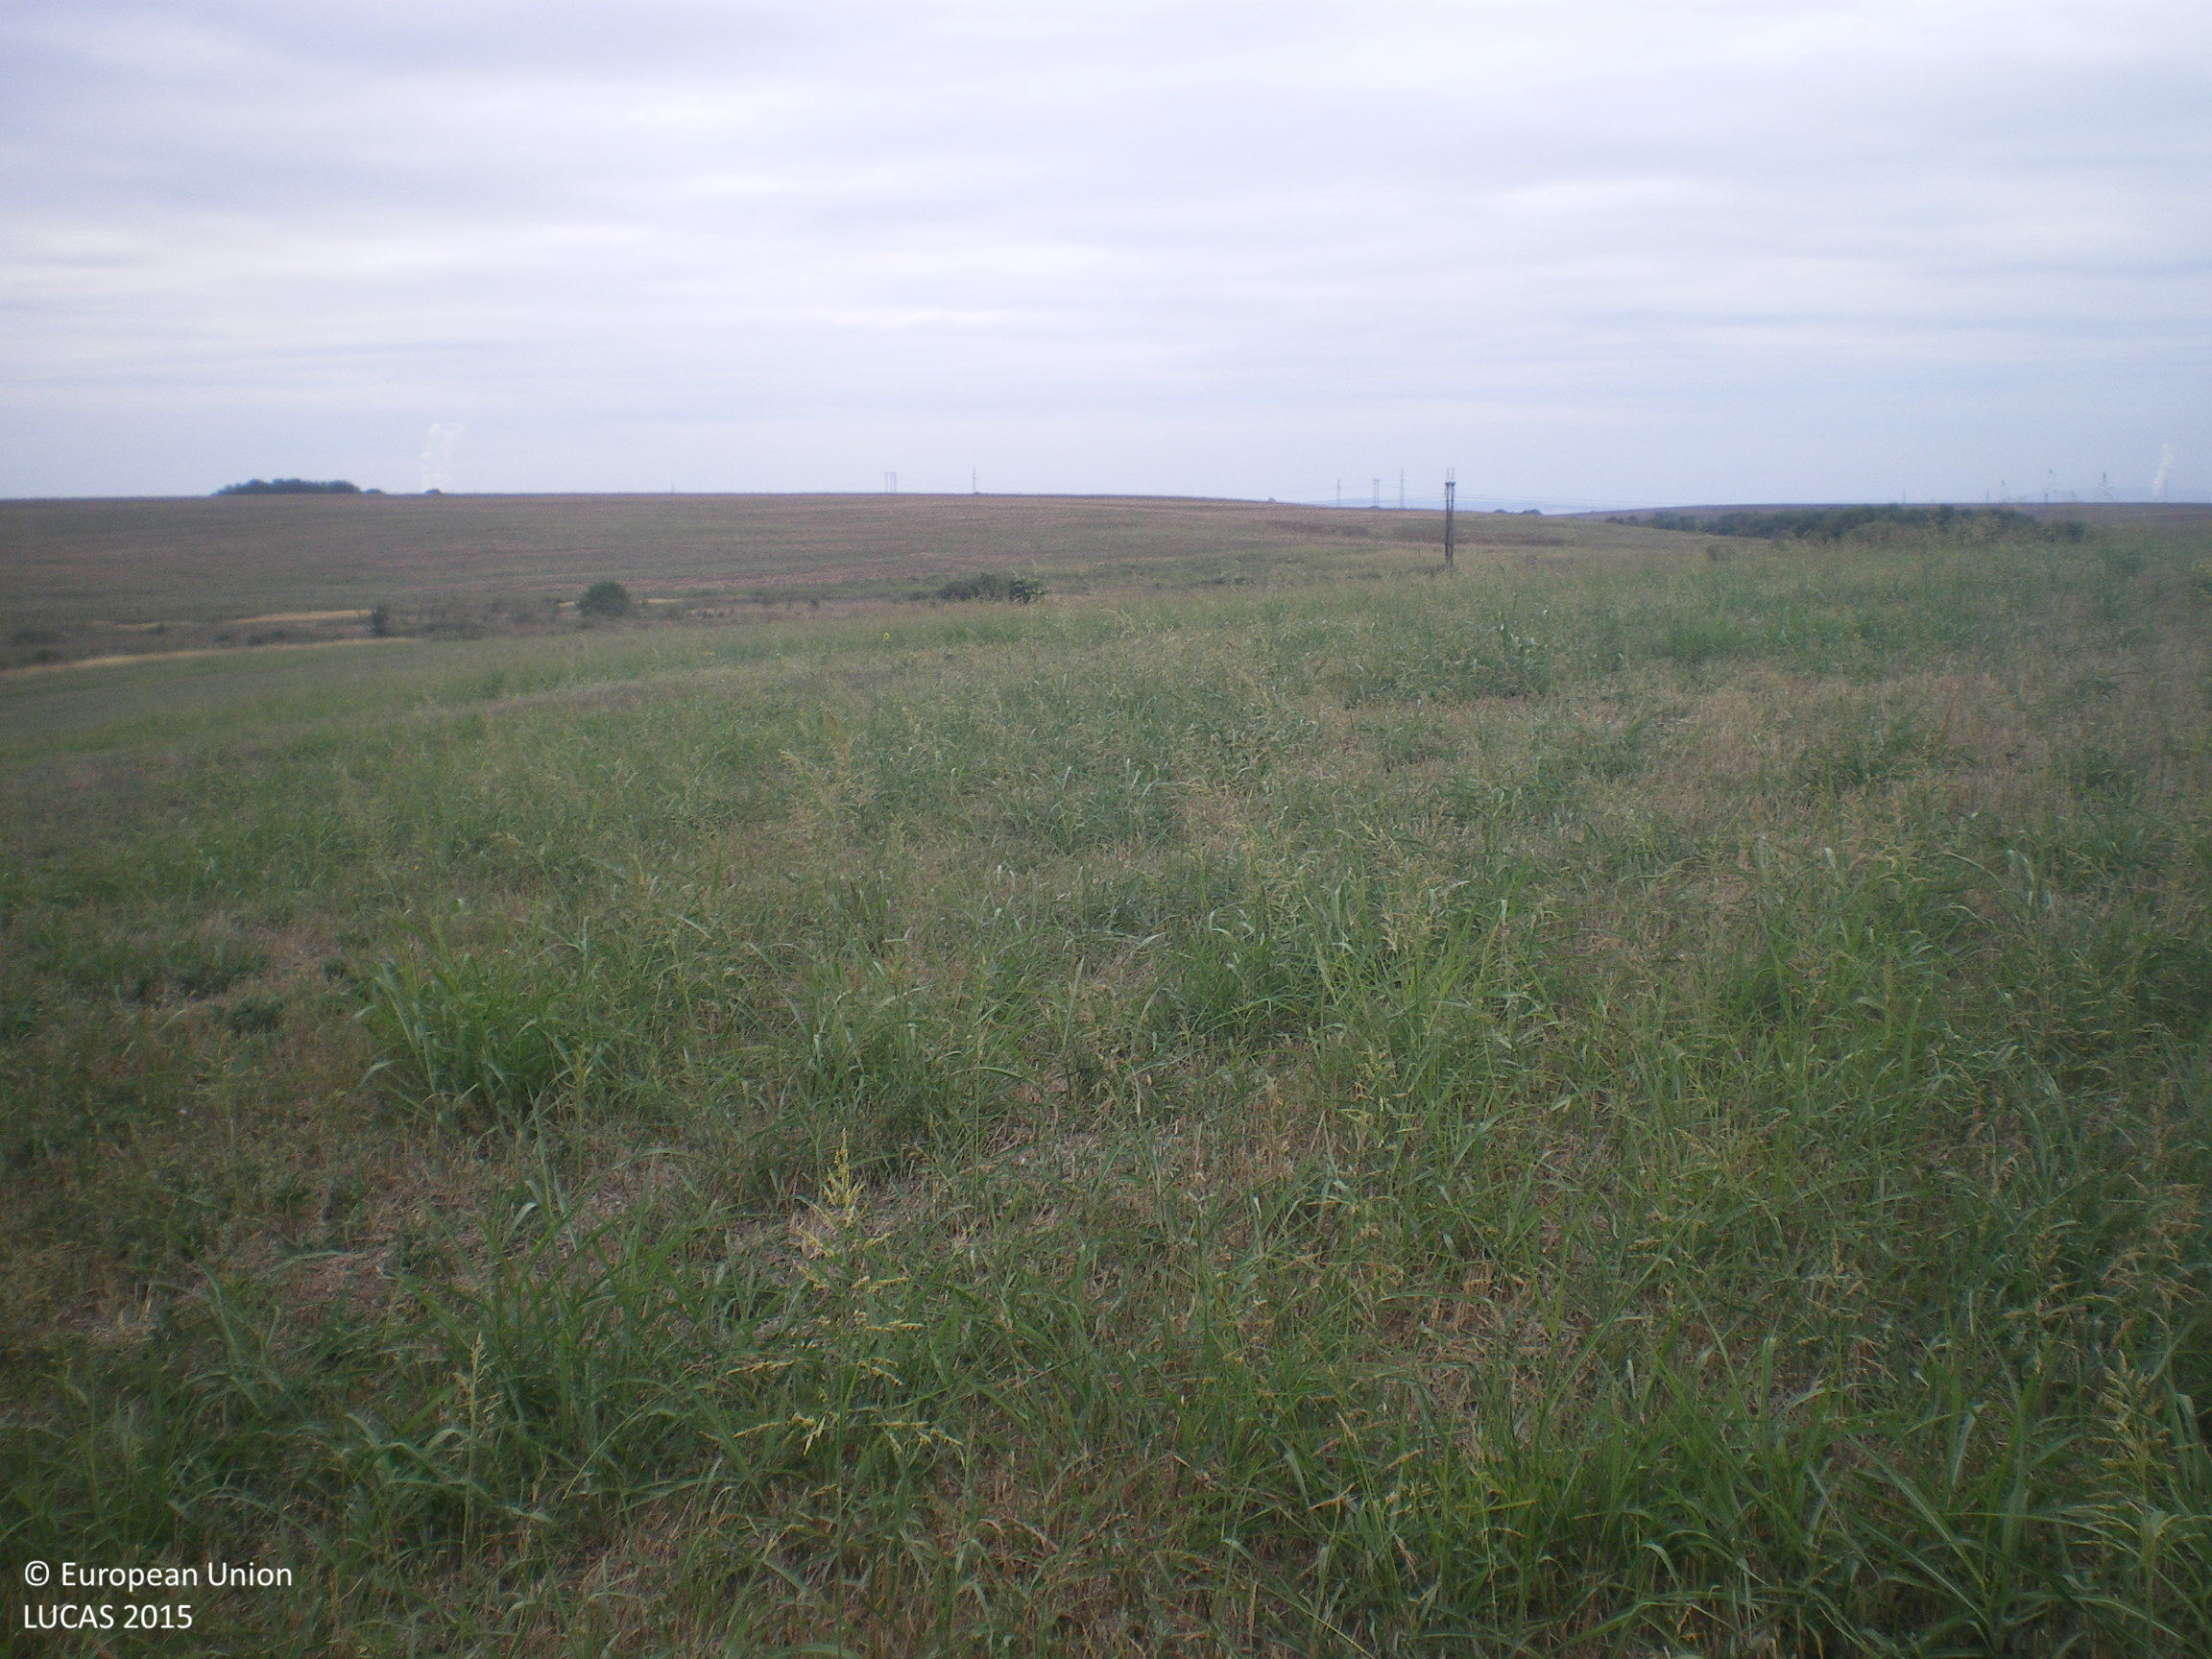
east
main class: Cropland
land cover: Rye
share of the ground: 10 - 25 %
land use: Agriculture (excluding fallow land and kitchen gardens)
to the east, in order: Rye; Spontaneously vegetated surfaces; Grassland without tree/shrub cover
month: September
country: BG
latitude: 42.2255
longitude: 25.8363
